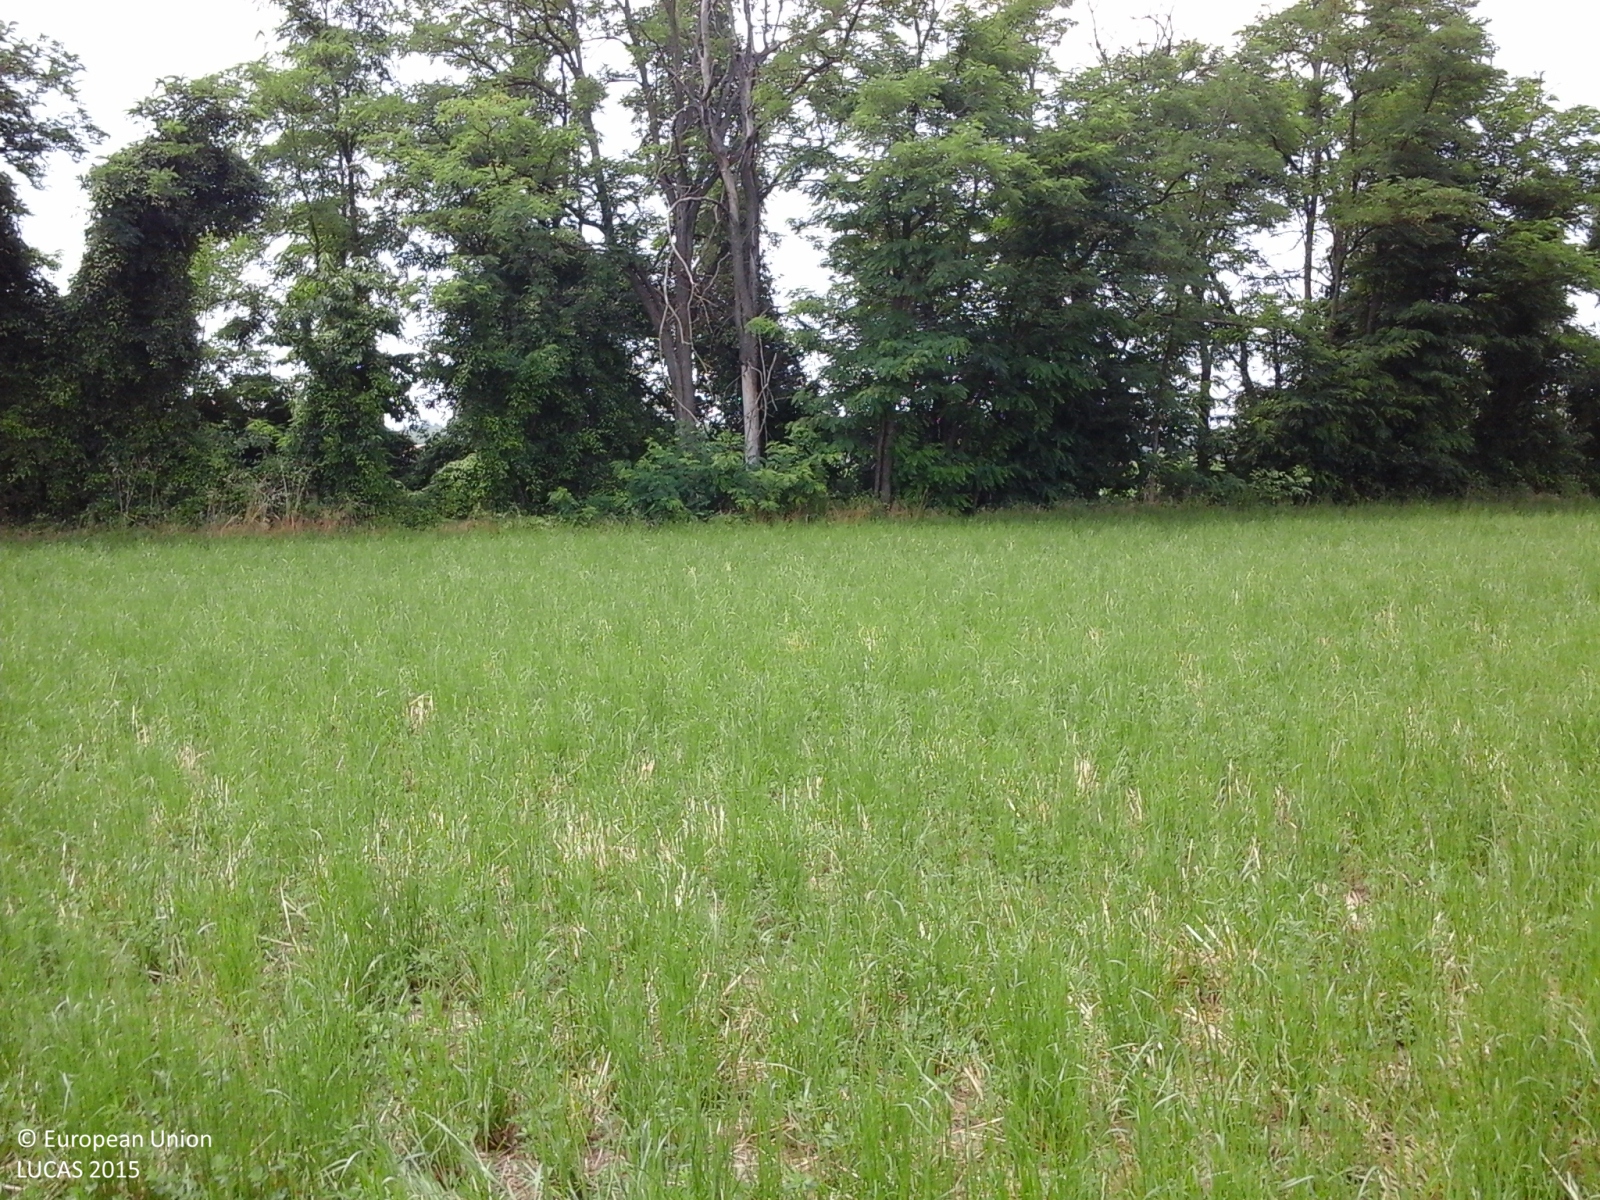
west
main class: Grassland
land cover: Spontaneously vegetated surfaces
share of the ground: > 75 %
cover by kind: herbaceous plants 100 %
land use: Agriculture (excluding fallow land and kitchen gardens)
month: June
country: IT
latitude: 44.9091
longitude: 9.6840
